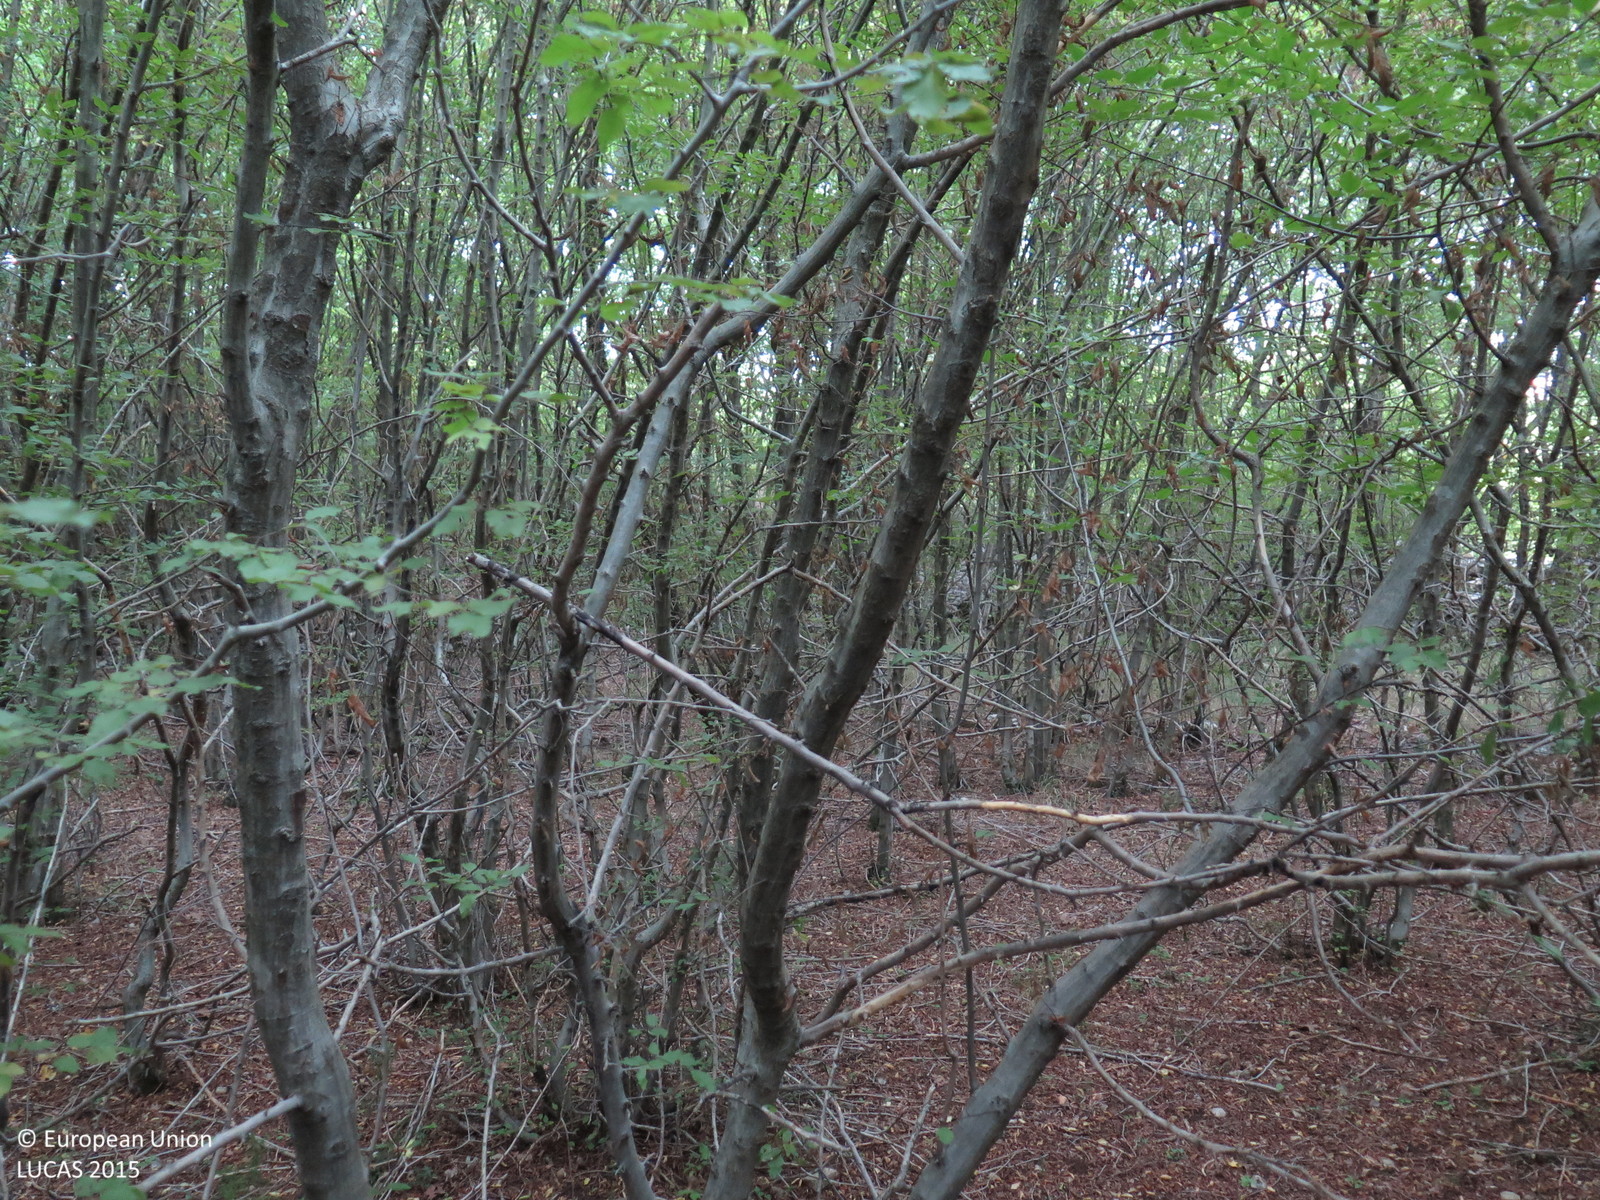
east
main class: Woodland
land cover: Broadleaved woodland
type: beech forest
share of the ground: > 75 %
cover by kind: broadleaved forest trees 100 %
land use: Forestry
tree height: > 5 m
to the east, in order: Broadleaved woodland; Dry stone walls; Broadleaved woodland; Dry stone walls; Broadleaved woodland; Dry stone walls; Rocks and stones; Grassland with sparse tree/shrub cover; Rocks and stones; Shrubland with sparse tree cover; Rocks and stones; Dry stone walls; Grassland with sparse tree/shrub cover; Dry stone walls; Broadleaved woodland
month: August
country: HR
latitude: 45.0970
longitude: 14.6072
